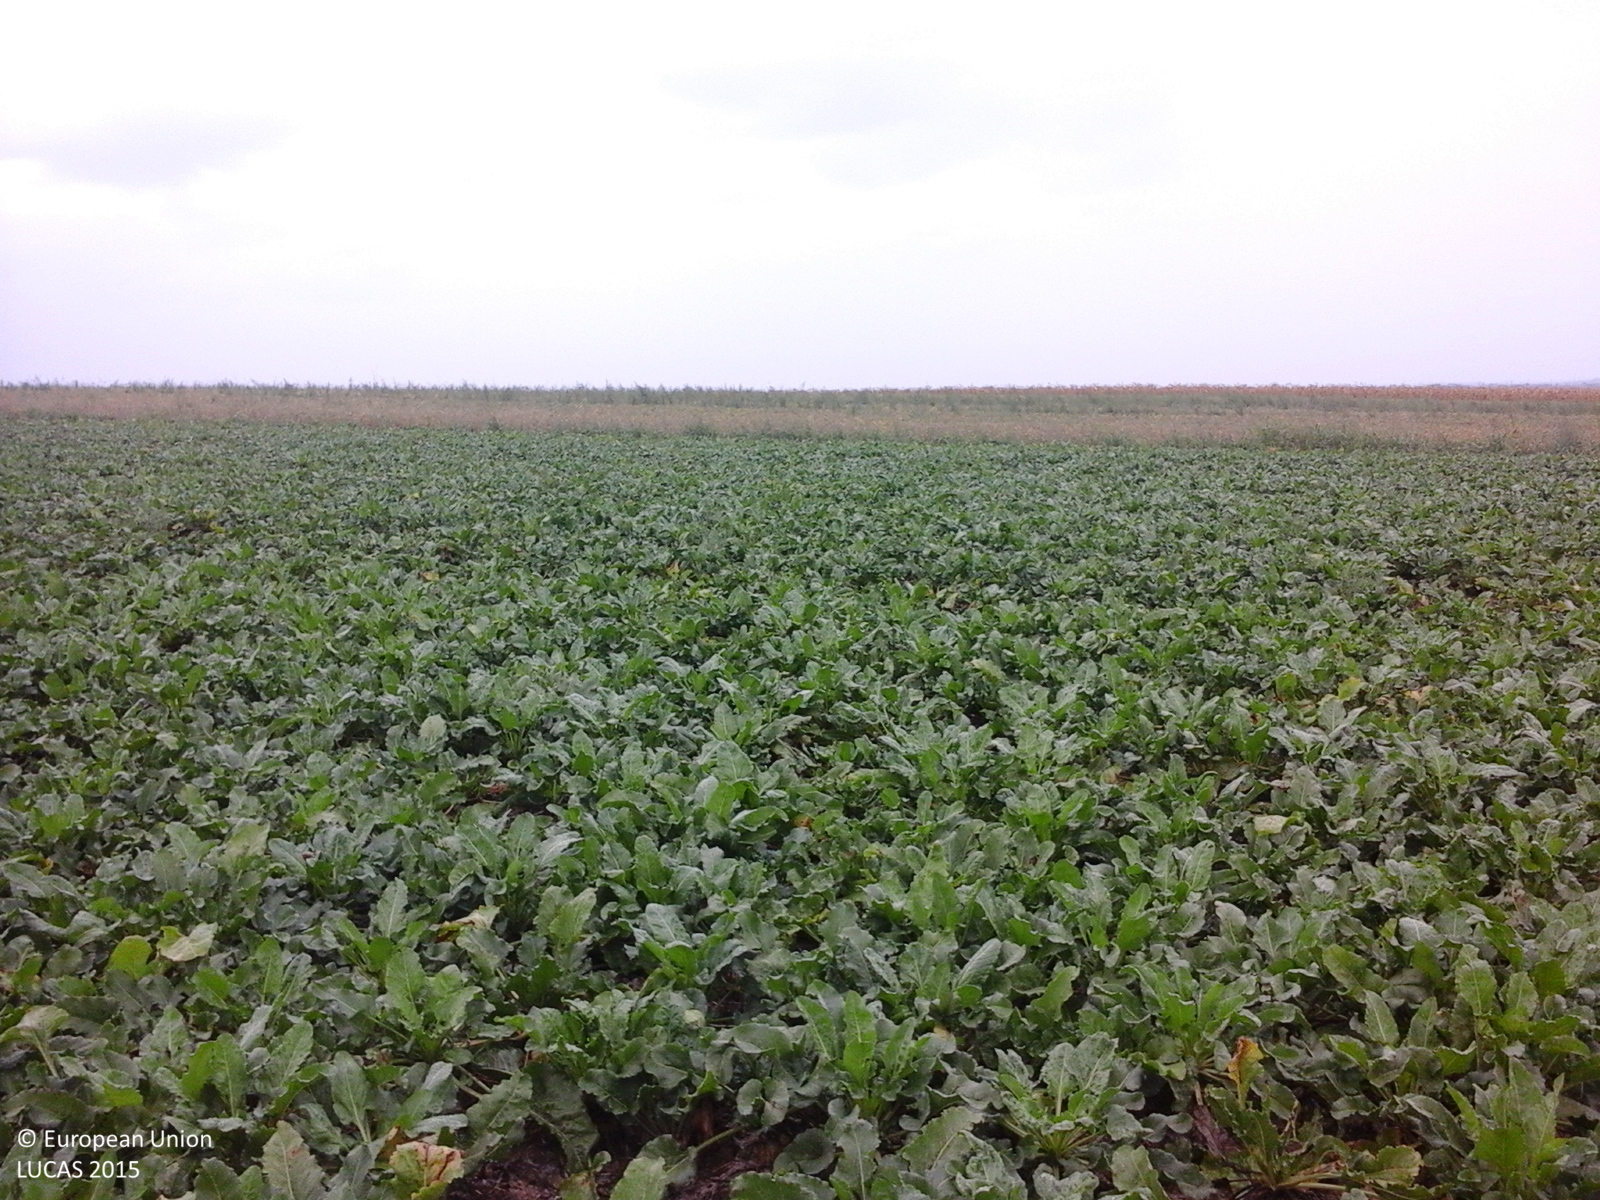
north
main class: Cropland
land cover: Sugar beet
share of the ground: > 75 %
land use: Agriculture (excluding fallow land and kitchen gardens)
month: September
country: RO
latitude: 47.3794
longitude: 22.0362
